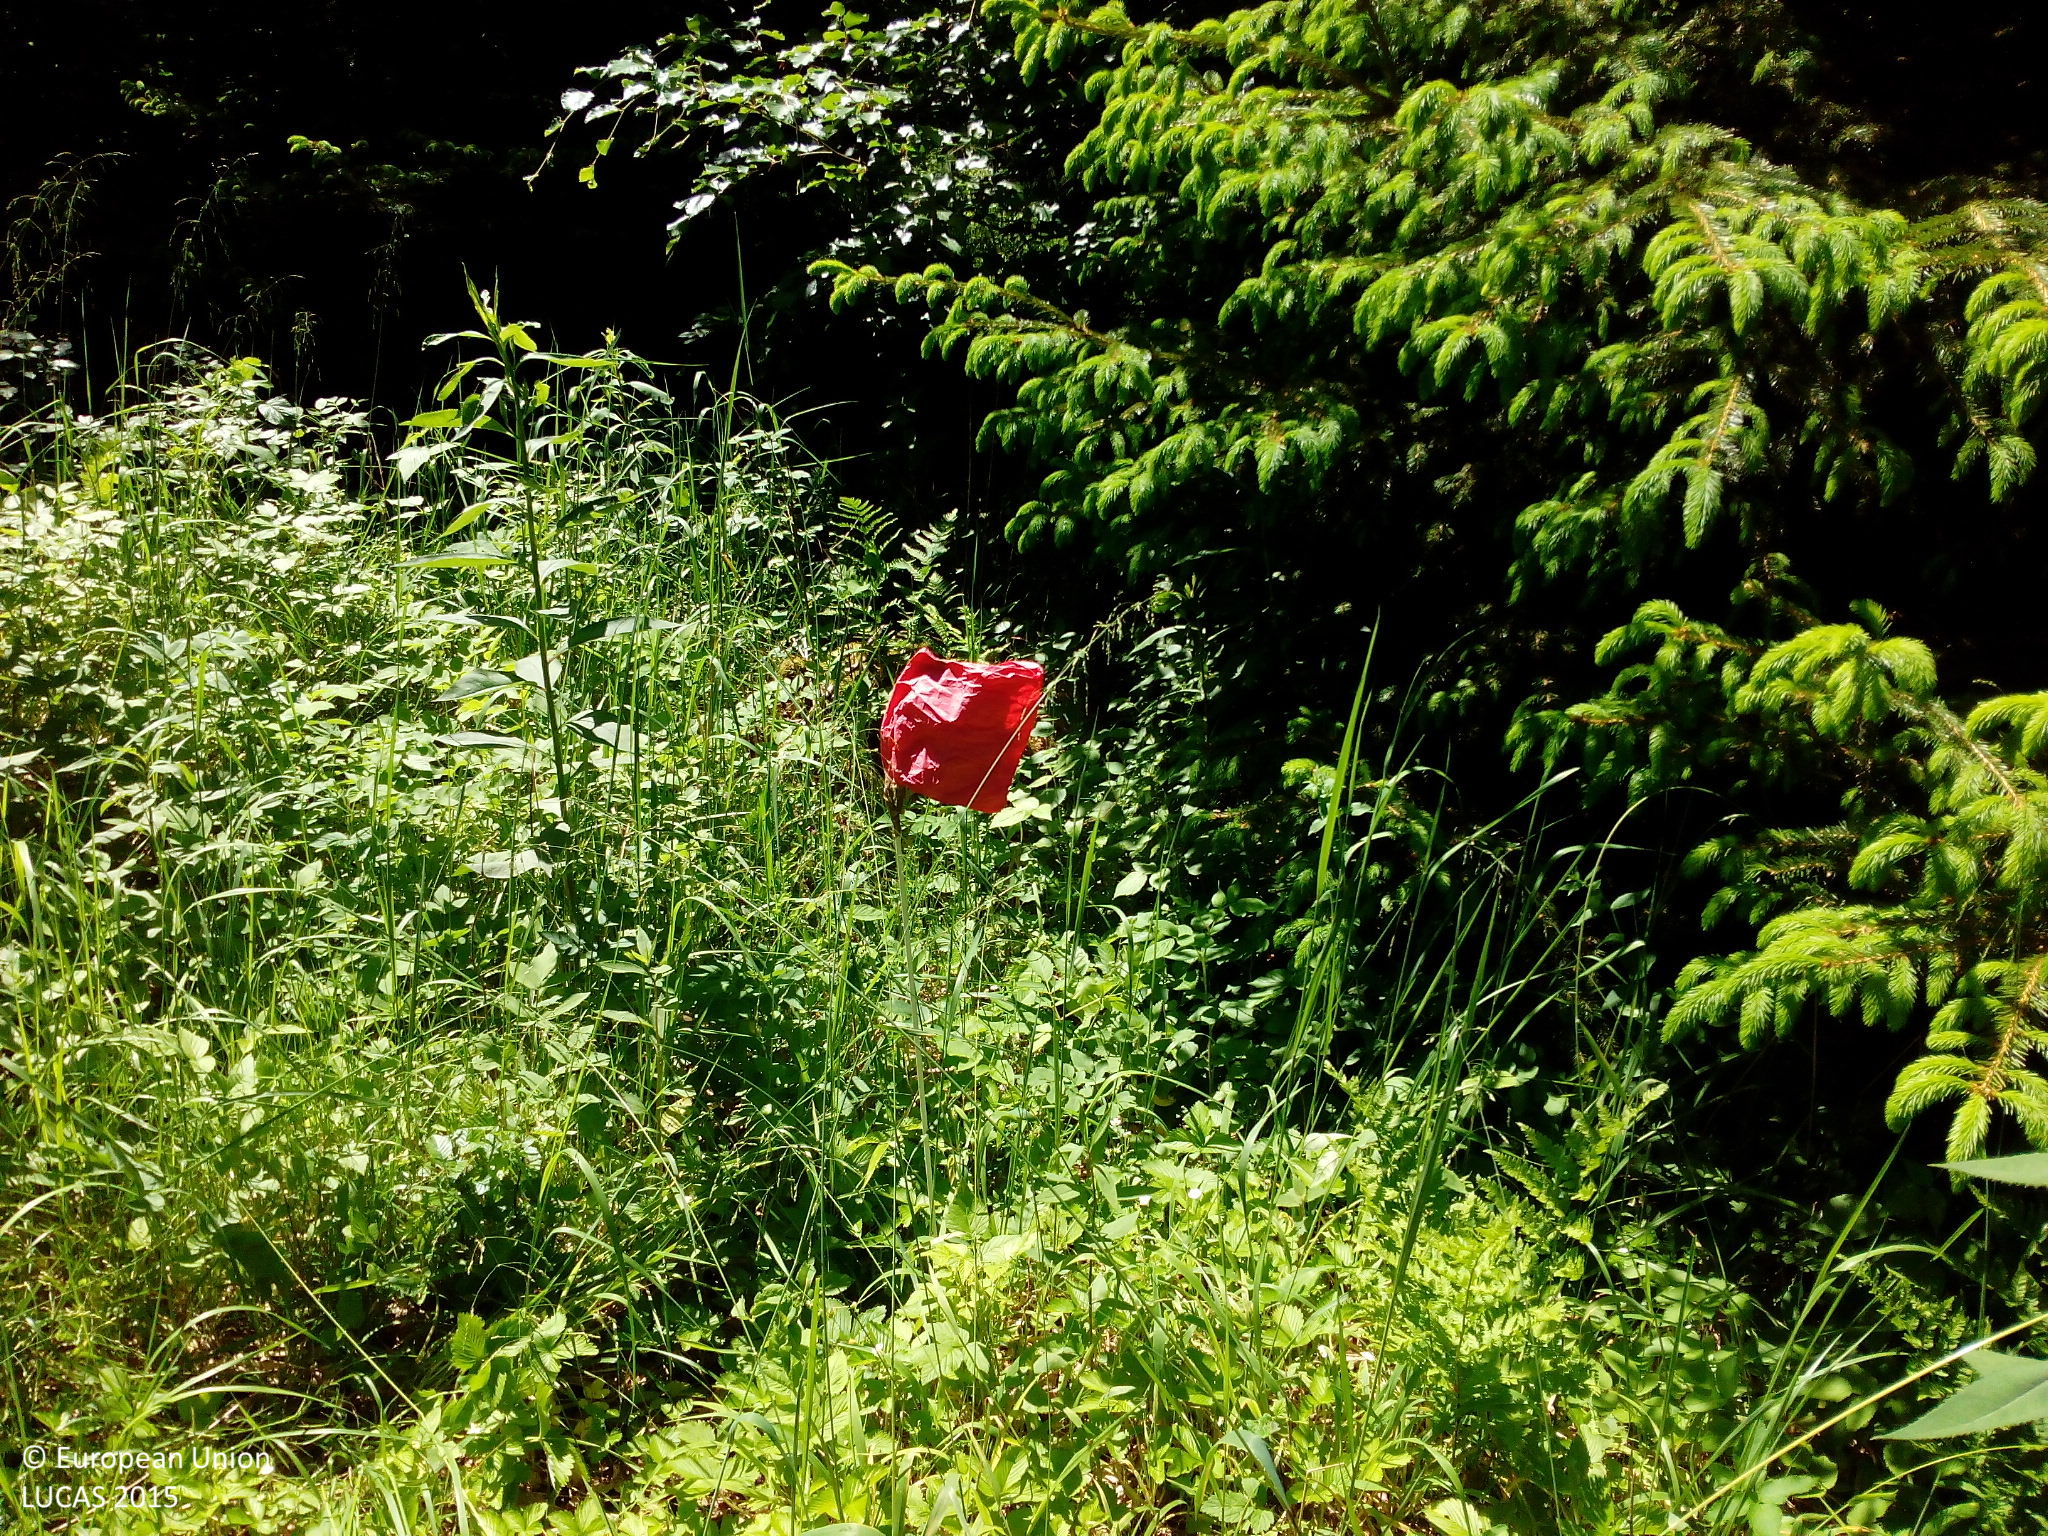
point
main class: Woodland
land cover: Spruce dominated mixed woodland
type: hemiboreal forest and nemoral coniferous forest and mixed broadleaved-coniferous forest
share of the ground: > 75 %
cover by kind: coniferous forest trees 50 %, broadleaved forest trees 40 %, shrubs 5 %, herbaceous plants 5 %
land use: Forestry
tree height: > 5 m
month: June
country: DE
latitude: 49.5532
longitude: 9.4058
